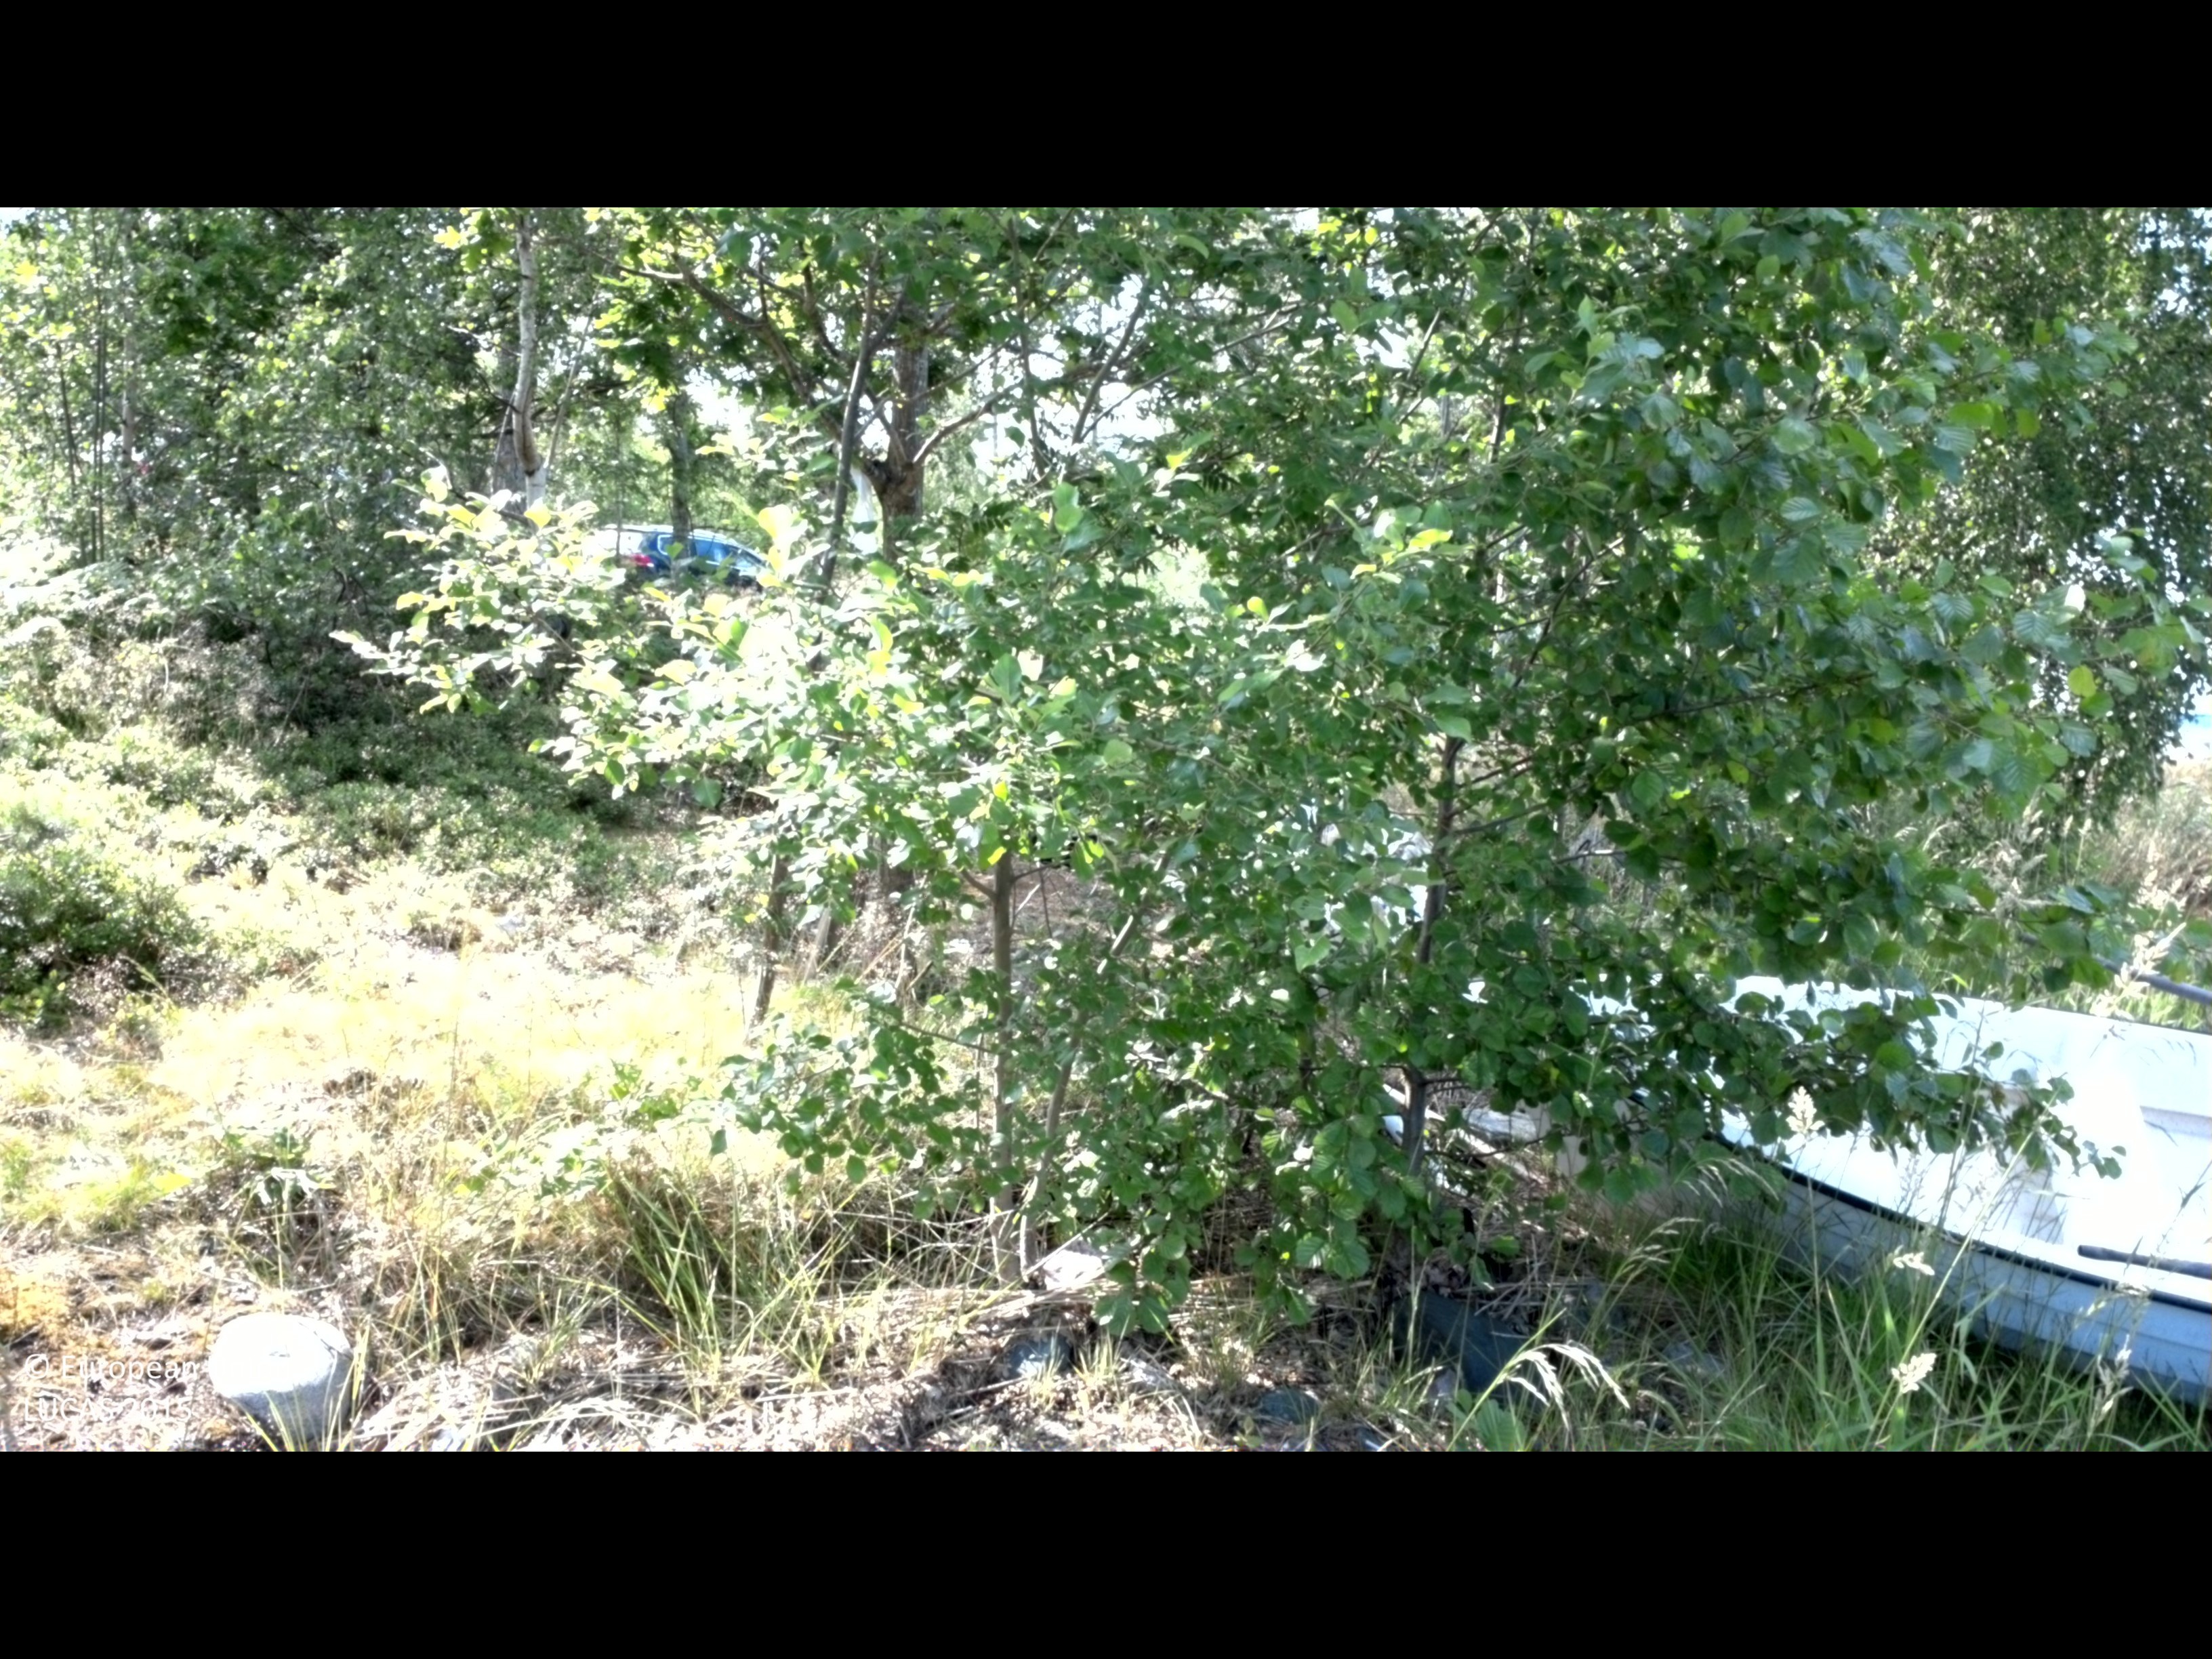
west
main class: Woodland
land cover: Broadleaved woodland
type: boreal forest
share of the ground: 50 - 75 %
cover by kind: broadleaved forest trees 65 %, shrubs 25 %, coniferous forest trees 5 %
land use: Amenities, museums, leisure
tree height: > 5 m
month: July
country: SE
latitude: 58.3229
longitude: 16.7071
